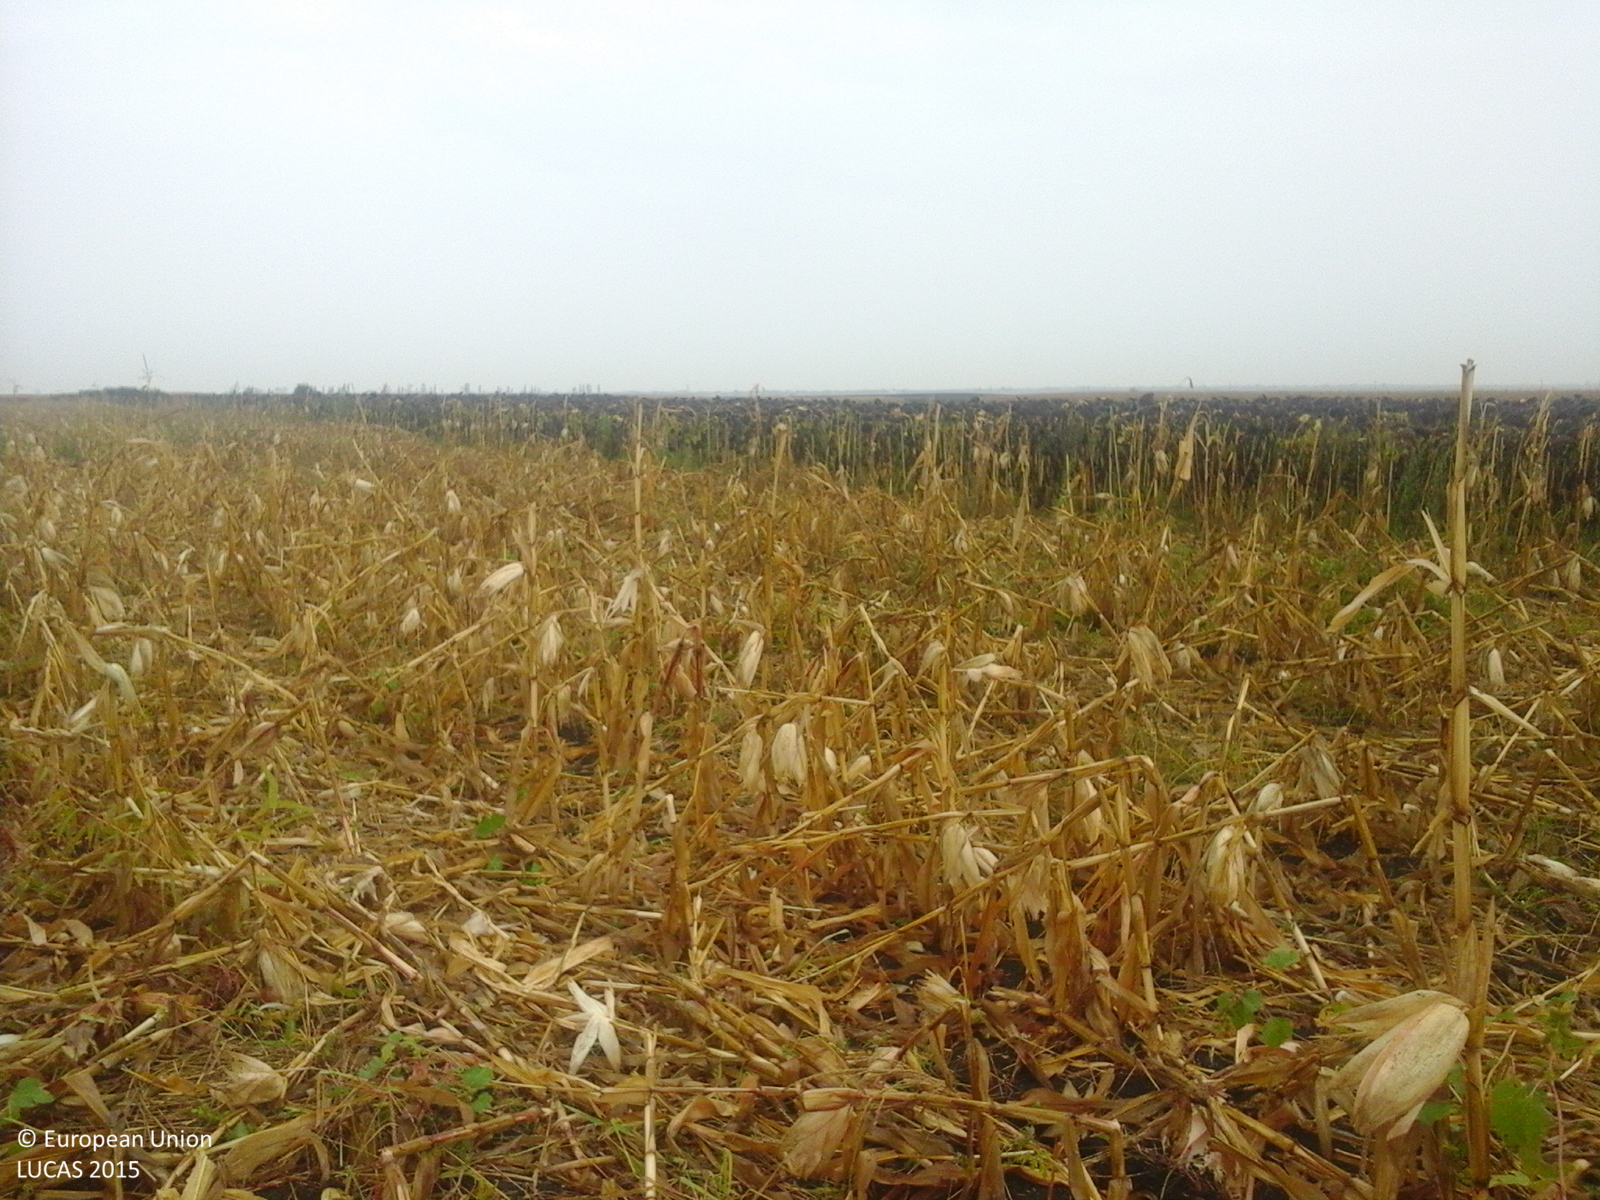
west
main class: Cropland
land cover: Maize
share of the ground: > 75 %
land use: Agriculture (excluding fallow land and kitchen gardens)
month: September
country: RO
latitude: 47.6152
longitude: 22.5241
